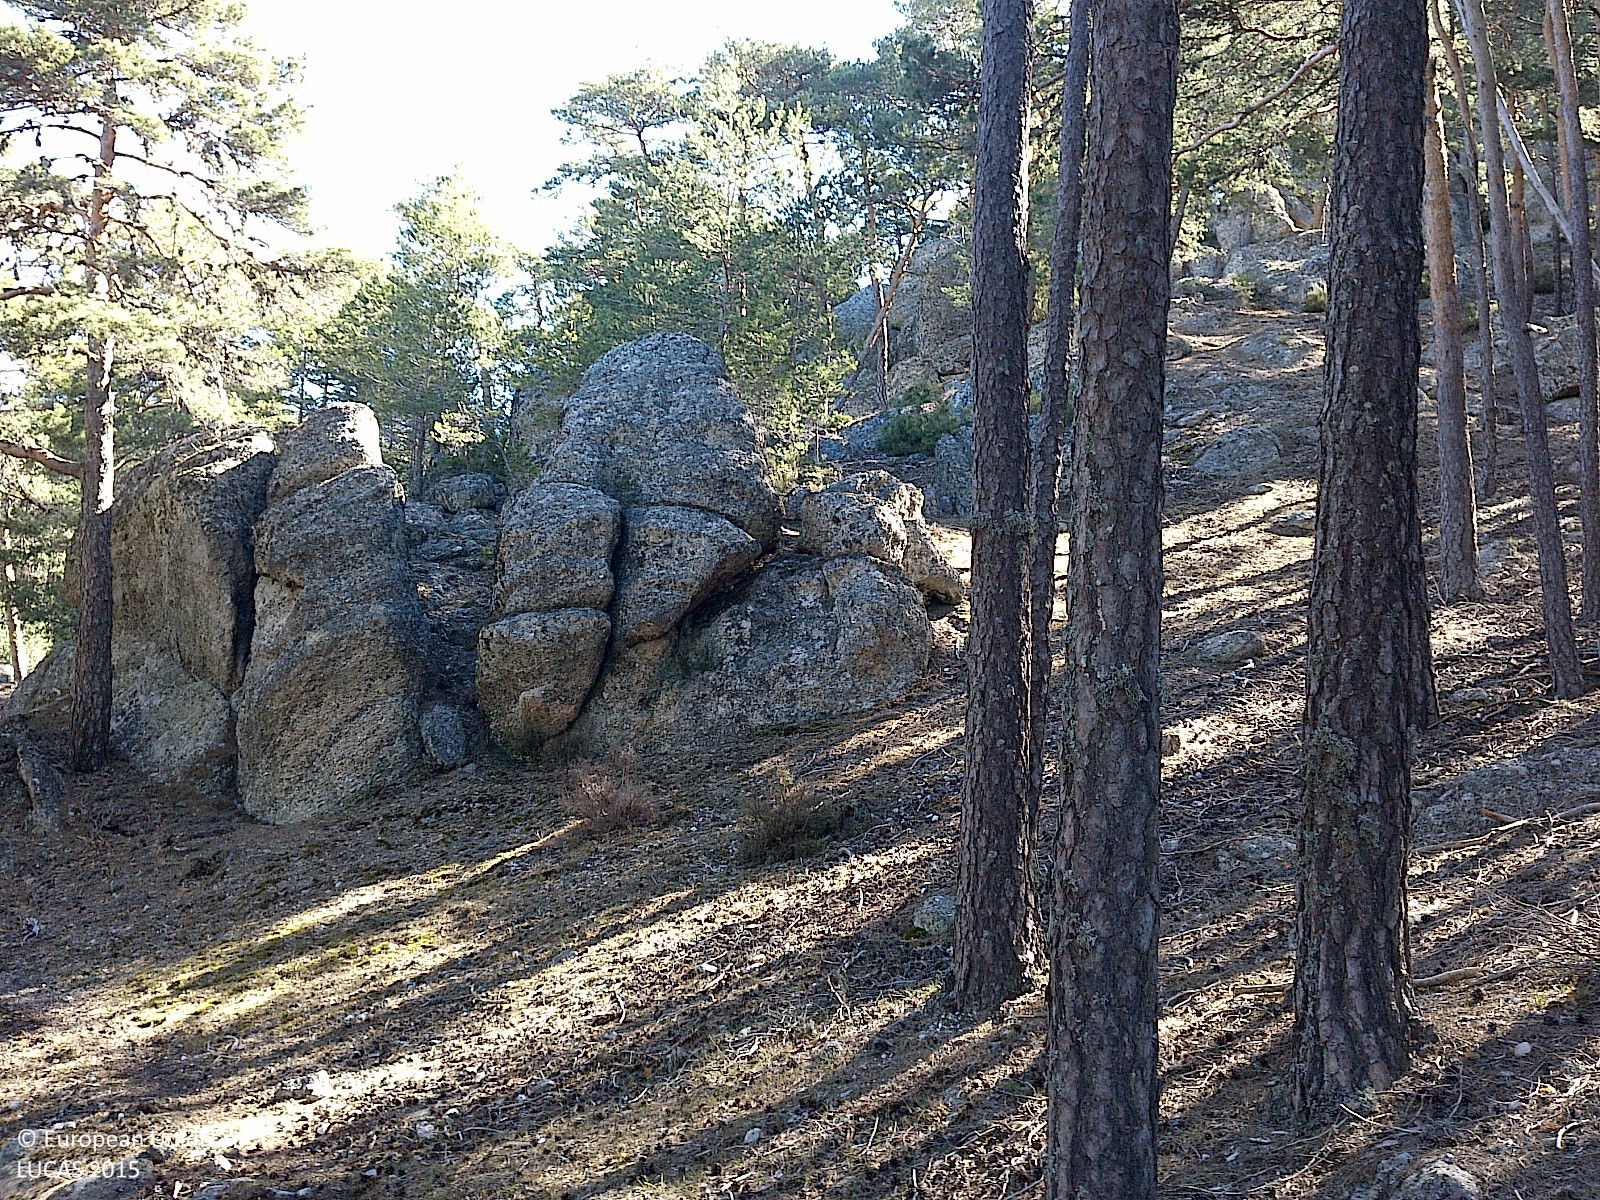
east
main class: Woodland
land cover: Pine dominated coniferous woodland
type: coniferous forest of the mediterranean region
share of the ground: > 75 %
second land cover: Grassland without tree/shrub cover
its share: 10 - 25 %
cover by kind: coniferous forest trees 75 %, herbaceous plants 15 %, unconsolidated bare surface 10 %
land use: Forestry
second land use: Agriculture (excluding fallow land and kitchen gardens)
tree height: > 5 m
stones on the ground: 10 - 25 %
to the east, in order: Pine dominated coniferous woodland; Grassland without tree/shrub cover; Rock outcrops; Pine dominated coniferous woodland
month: April
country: ES
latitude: 41.9292
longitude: -3.0835
